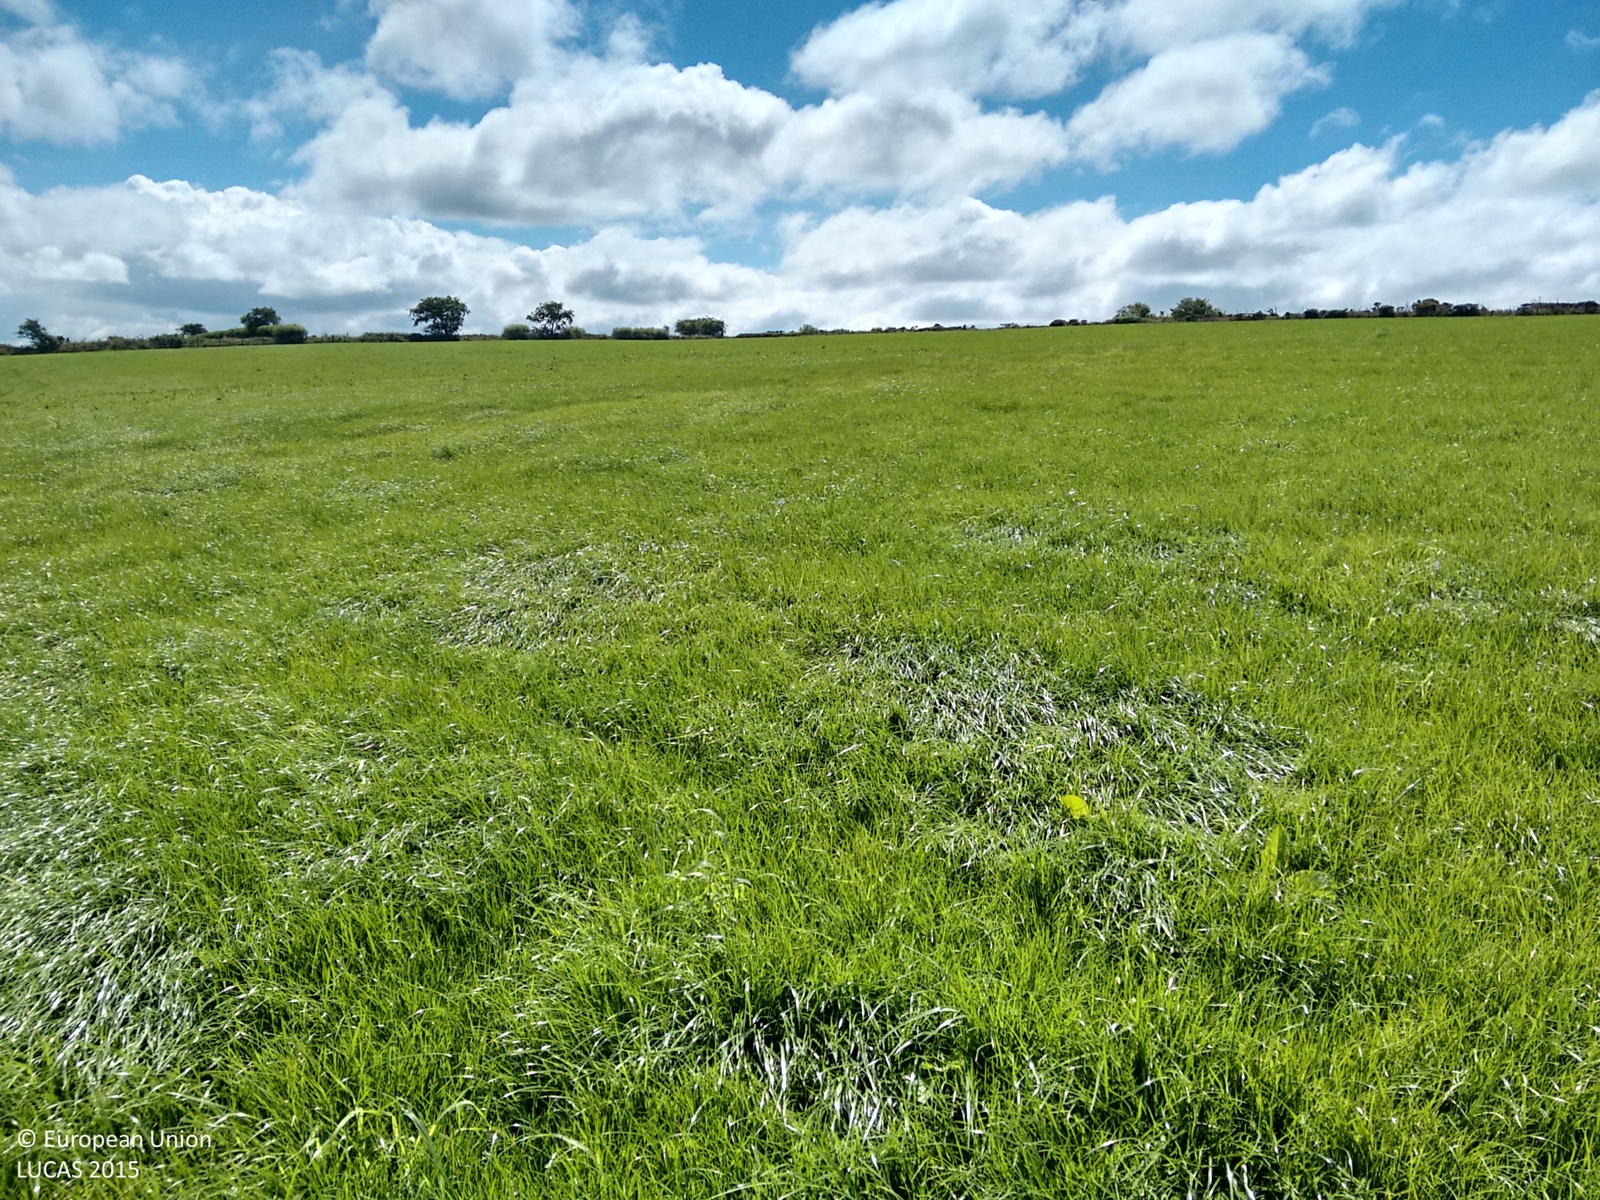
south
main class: Cropland
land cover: Temporary grasslands
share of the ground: > 75 %
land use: Agriculture (excluding fallow land and kitchen gardens)
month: August
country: GB
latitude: 52.1287
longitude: -4.2849
